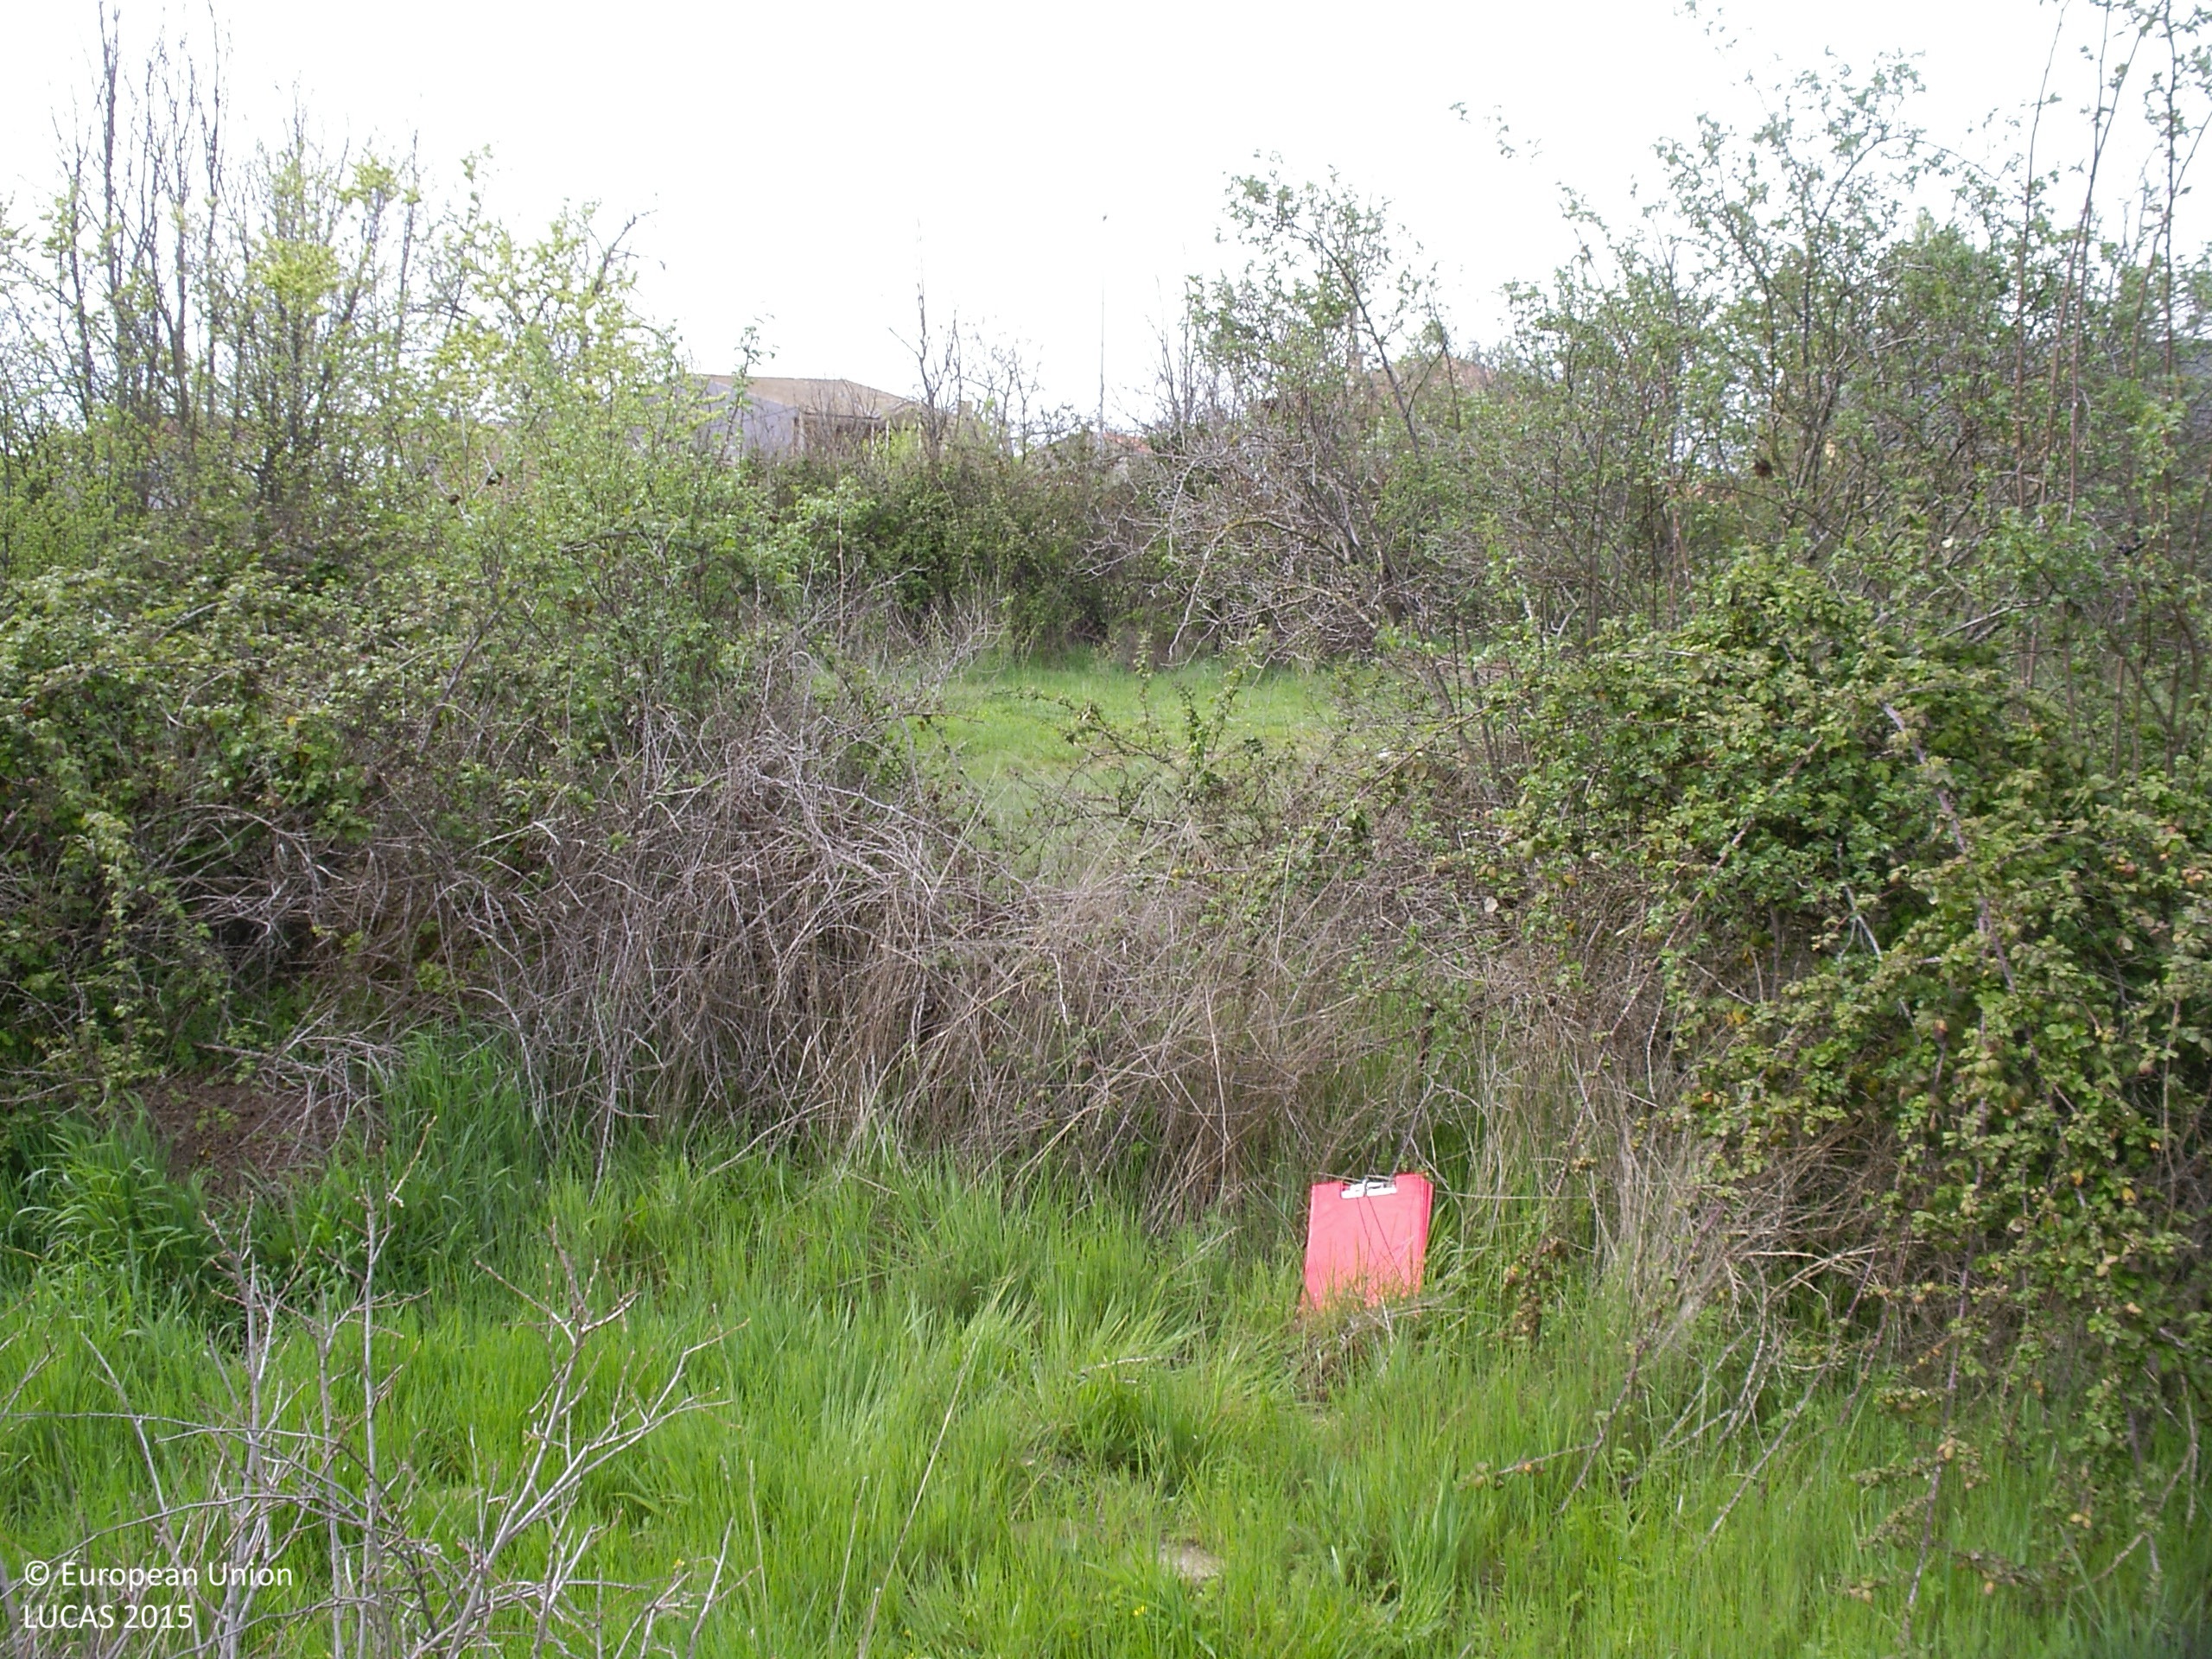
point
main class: Grassland
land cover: Grassland with sparse tree/shrub cover
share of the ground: > 75 %
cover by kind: herbaceous plants 90 %, broadleaved forest trees 5 %, shrubs 5 %
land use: Abandoned areas
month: April
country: ES
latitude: 42.4809
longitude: -5.7309
